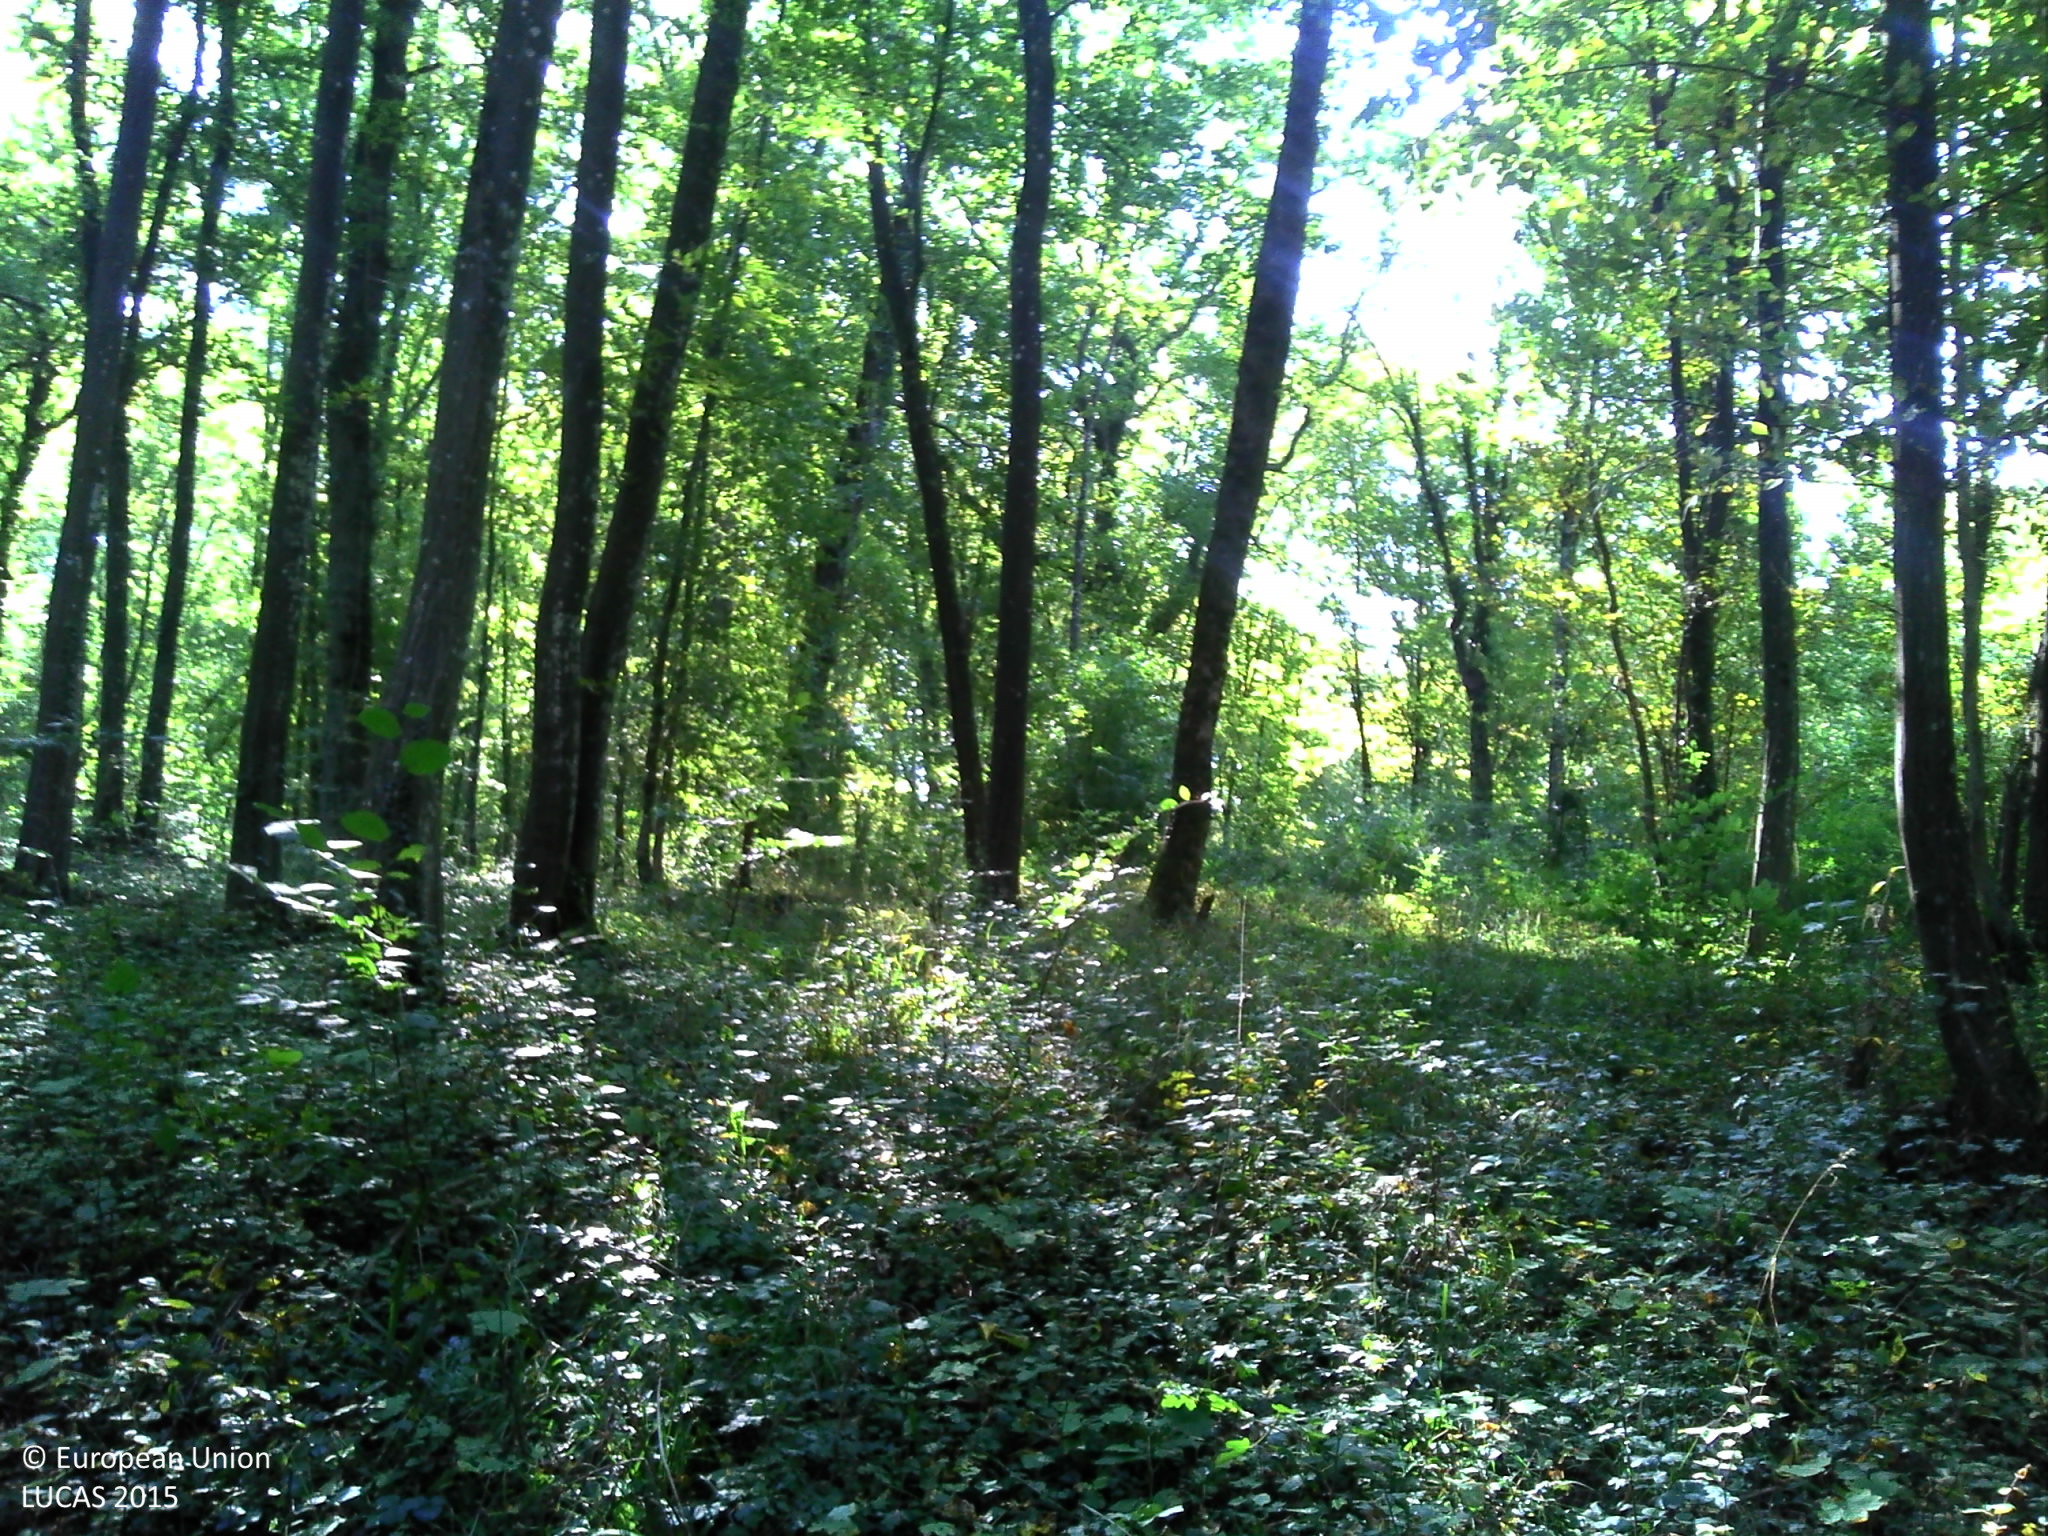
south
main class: Woodland
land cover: Broadleaved woodland
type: mesophytic deciduous forest
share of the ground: > 75 %
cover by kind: broadleaved forest trees 90 %, herbaceous plants 5 %, consolidated bare surface 5 %
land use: Forestry
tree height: > 5 m
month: September
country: FR
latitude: 49.2838
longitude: 5.9439
